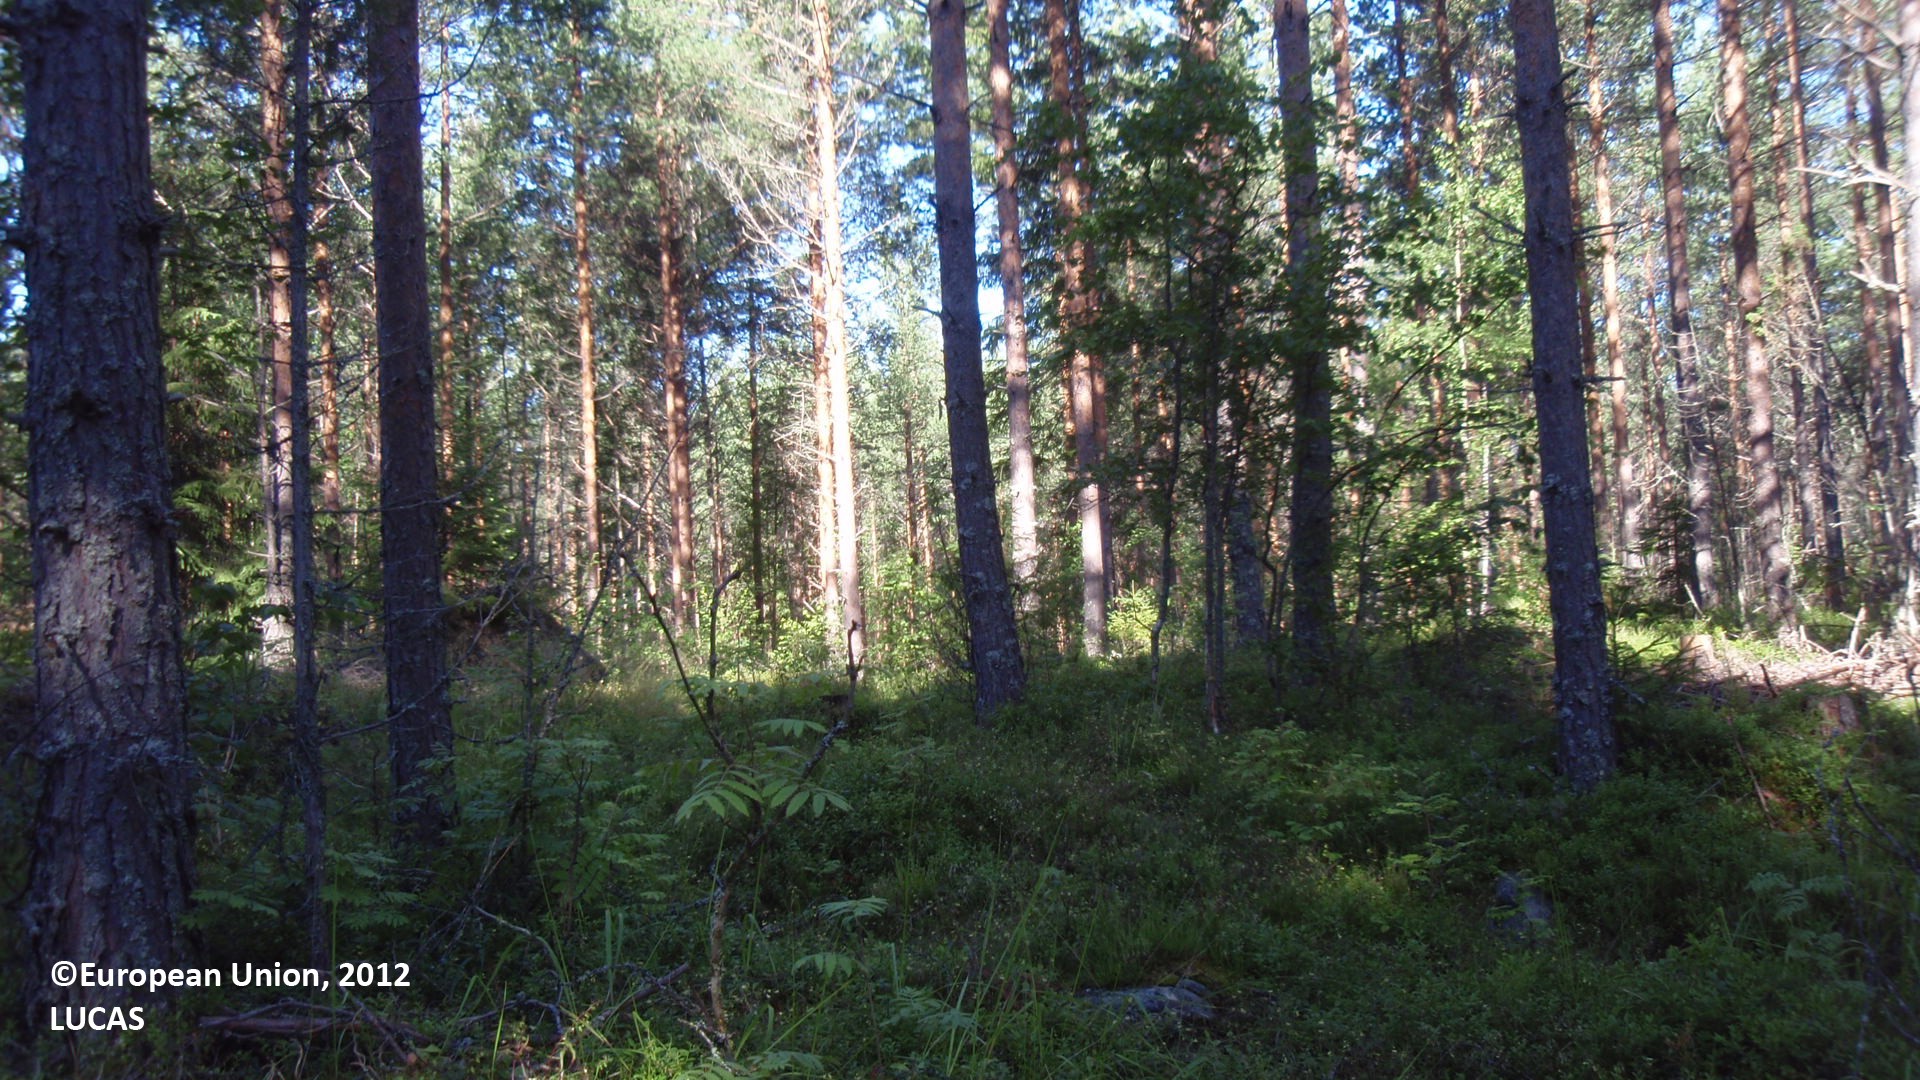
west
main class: Woodland
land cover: Pine dominated coniferous woodland
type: boreal forest
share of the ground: 50 - 75 %
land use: Forestry
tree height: > 5 m
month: July
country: FI
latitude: 61.5770
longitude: 28.2247
